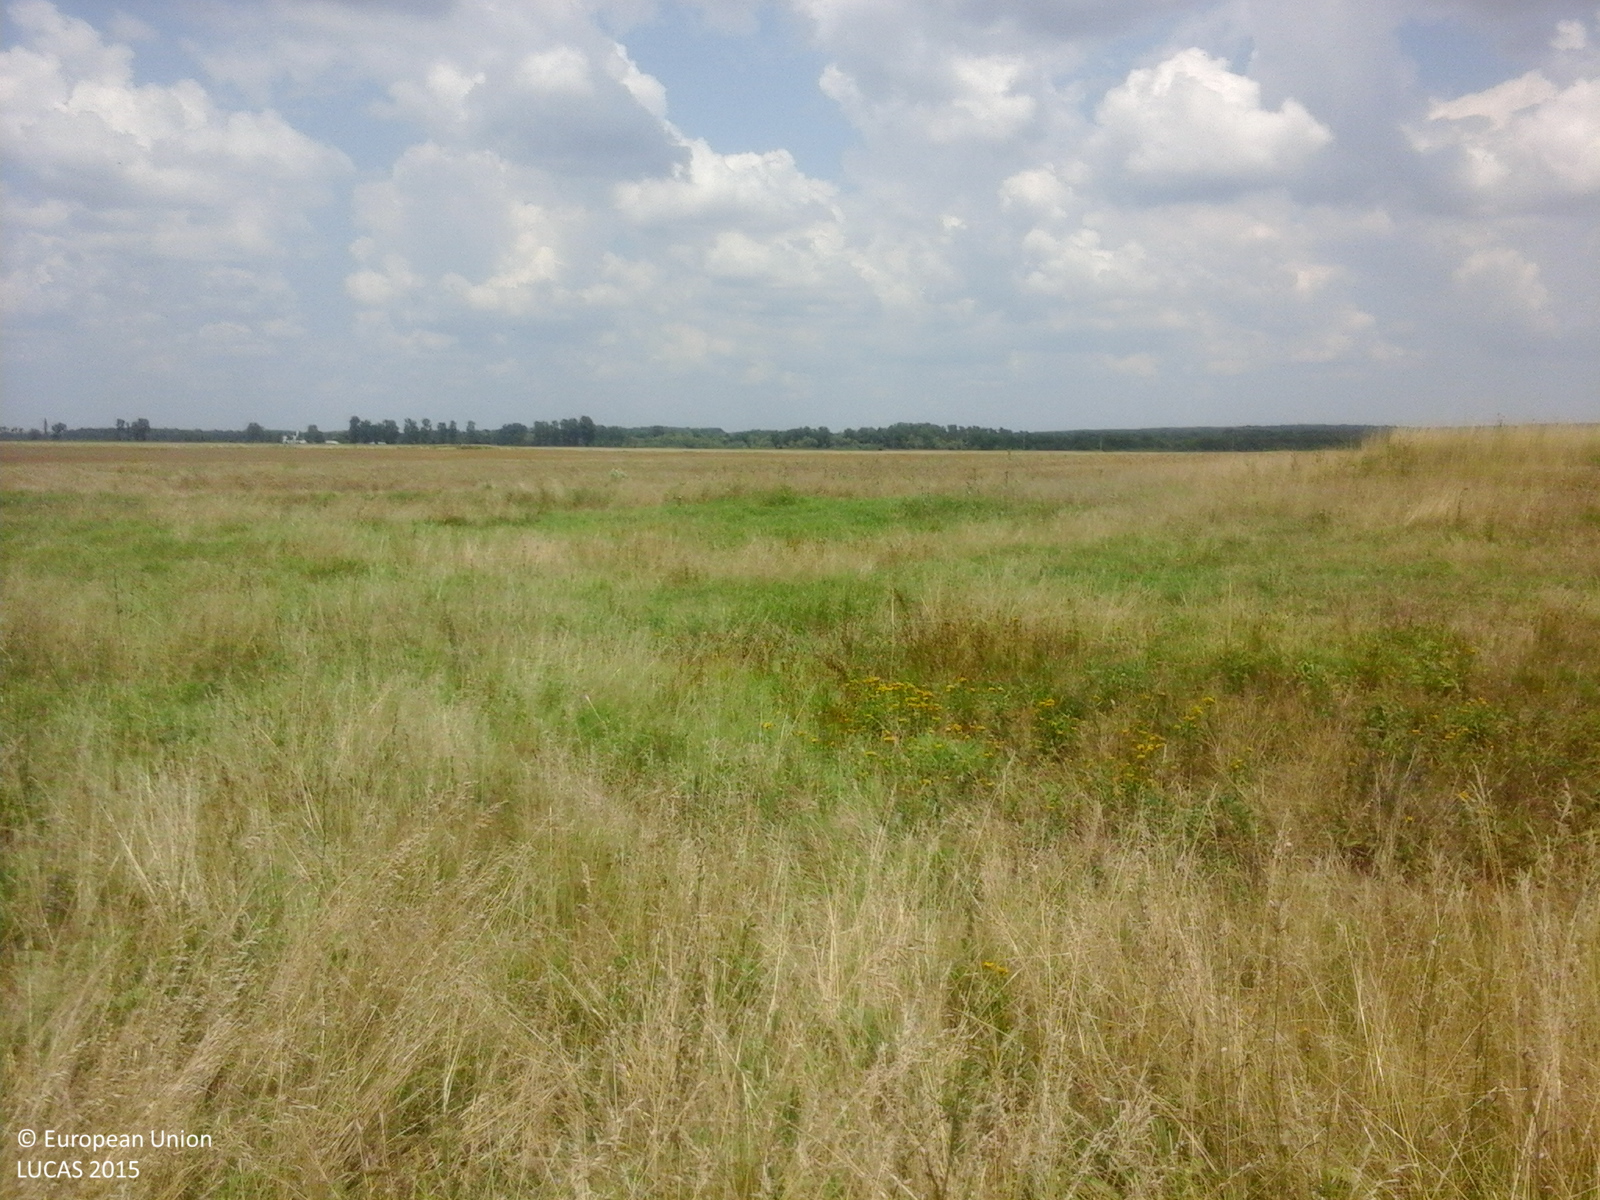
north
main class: Grassland
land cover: Grassland without tree/shrub cover
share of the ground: > 75 %
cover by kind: herbaceous plants 100 %
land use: Agriculture (excluding fallow land and kitchen gardens)
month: July
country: RO
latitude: 44.0441
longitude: 25.3471
